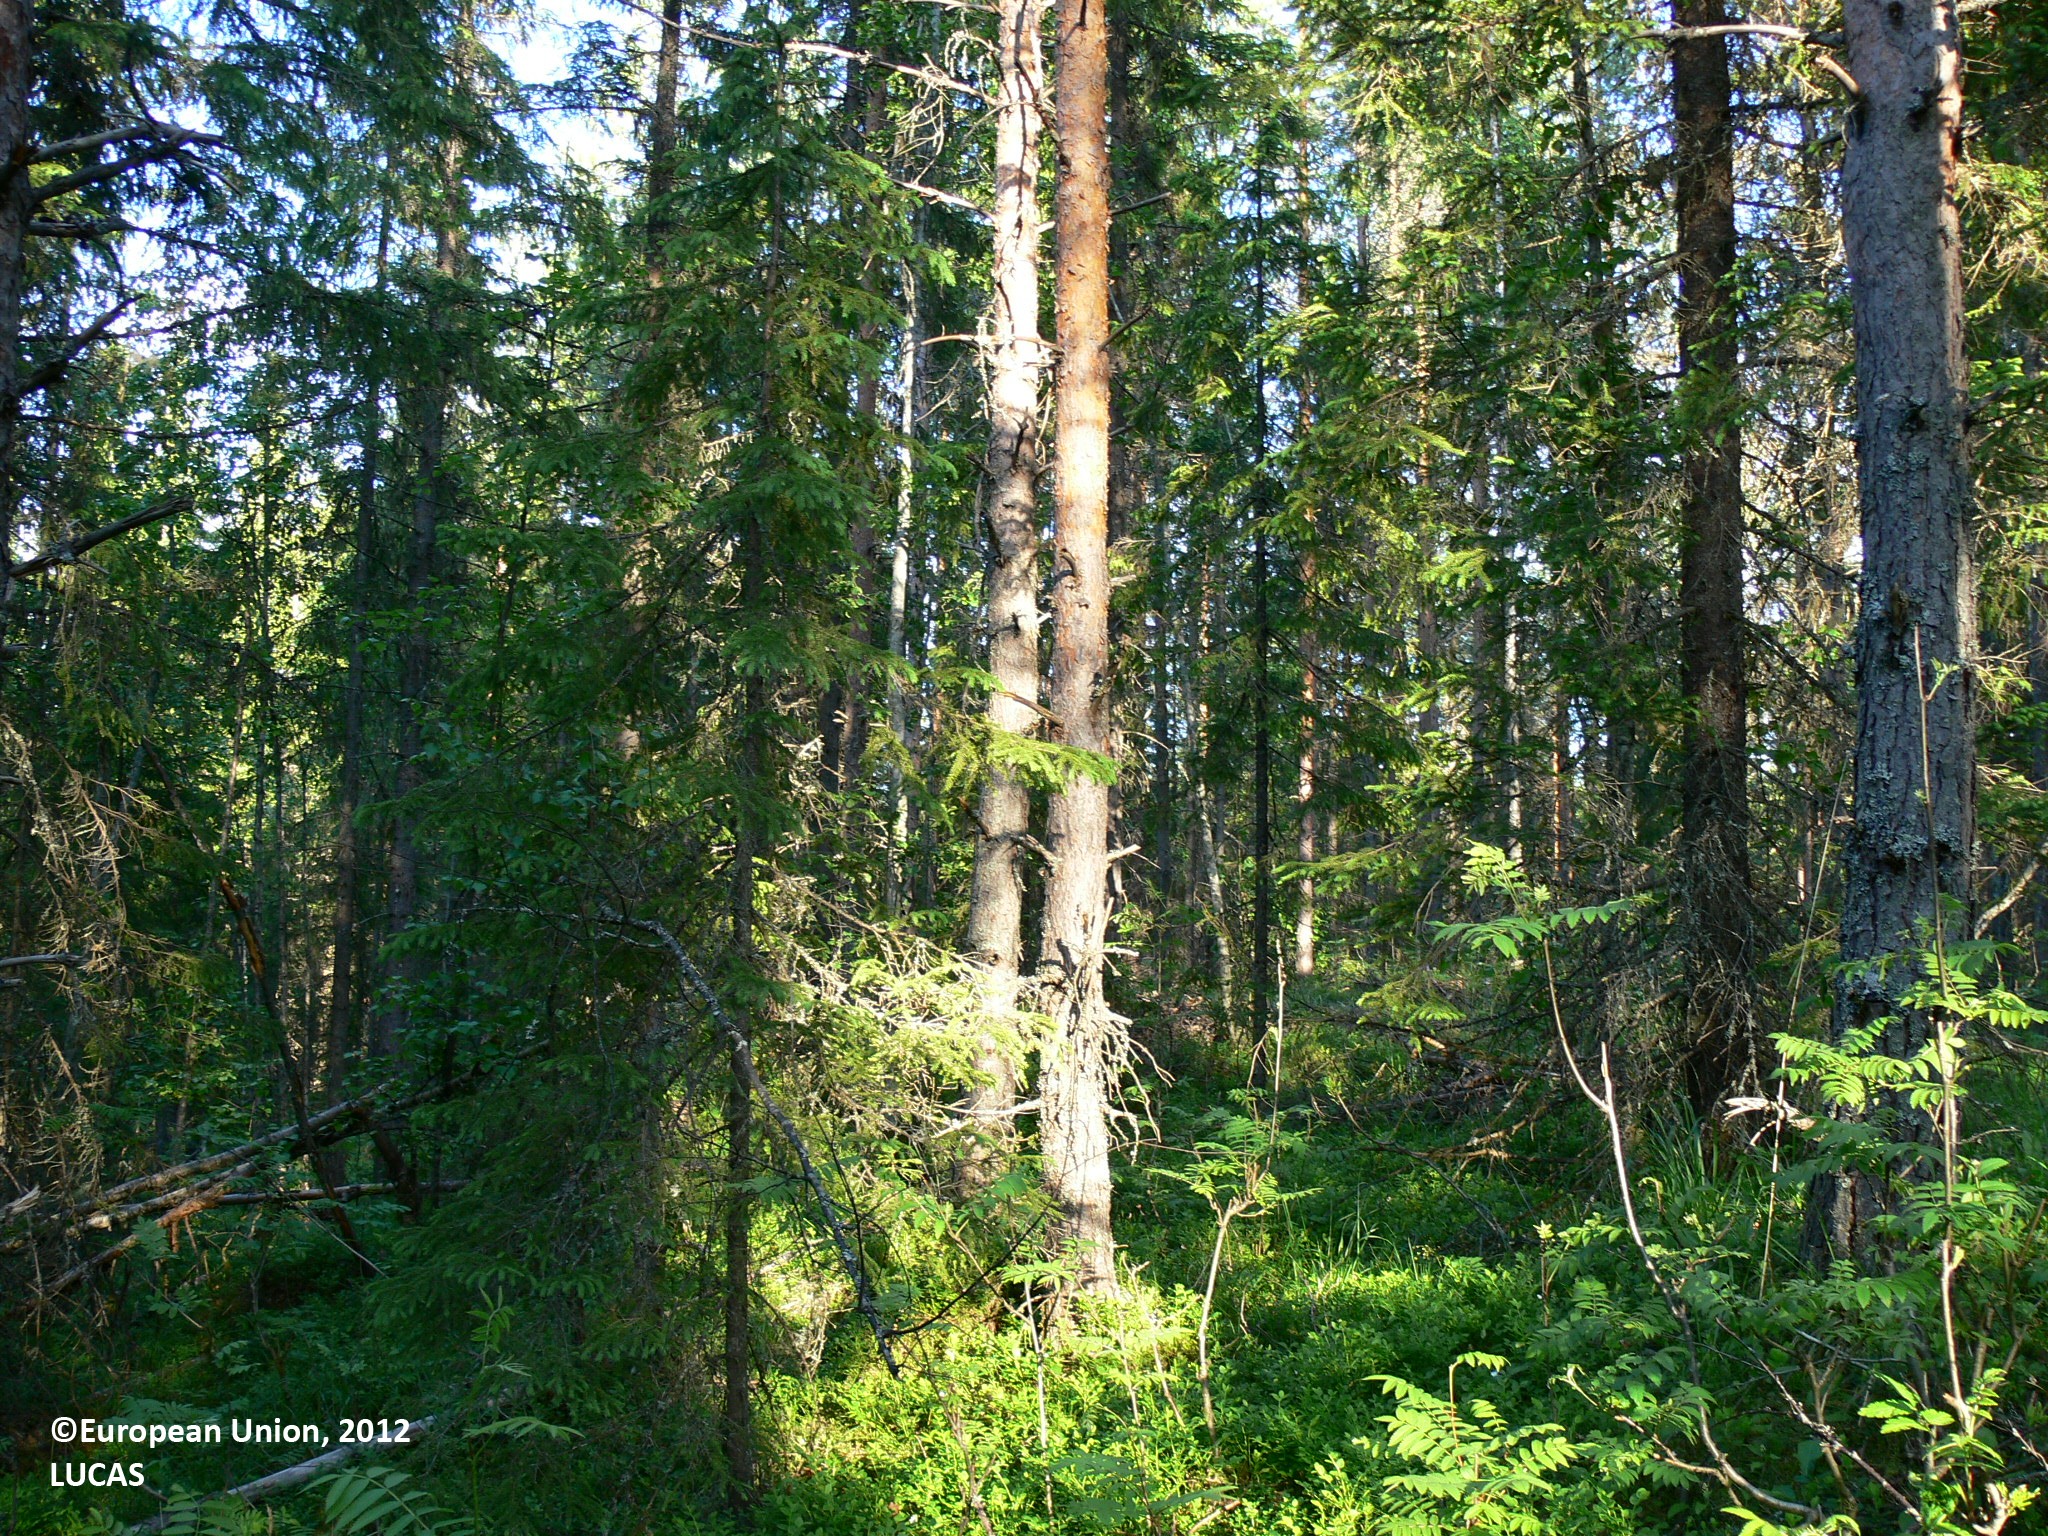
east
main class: Woodland
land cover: Other mixed woodland
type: boreal forest
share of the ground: > 75 %
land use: Forestry
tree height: > 5 m
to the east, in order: Other mixed woodland; Spruce dominated coniferous woodland; Pine dominated coniferous woodland; Other coniferous woodland; Pine dominated coniferous woodland; Other mixed woodland; Ditches and canals; Other mixed woodland
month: June
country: FI
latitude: 62.2882
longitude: 30.5867
